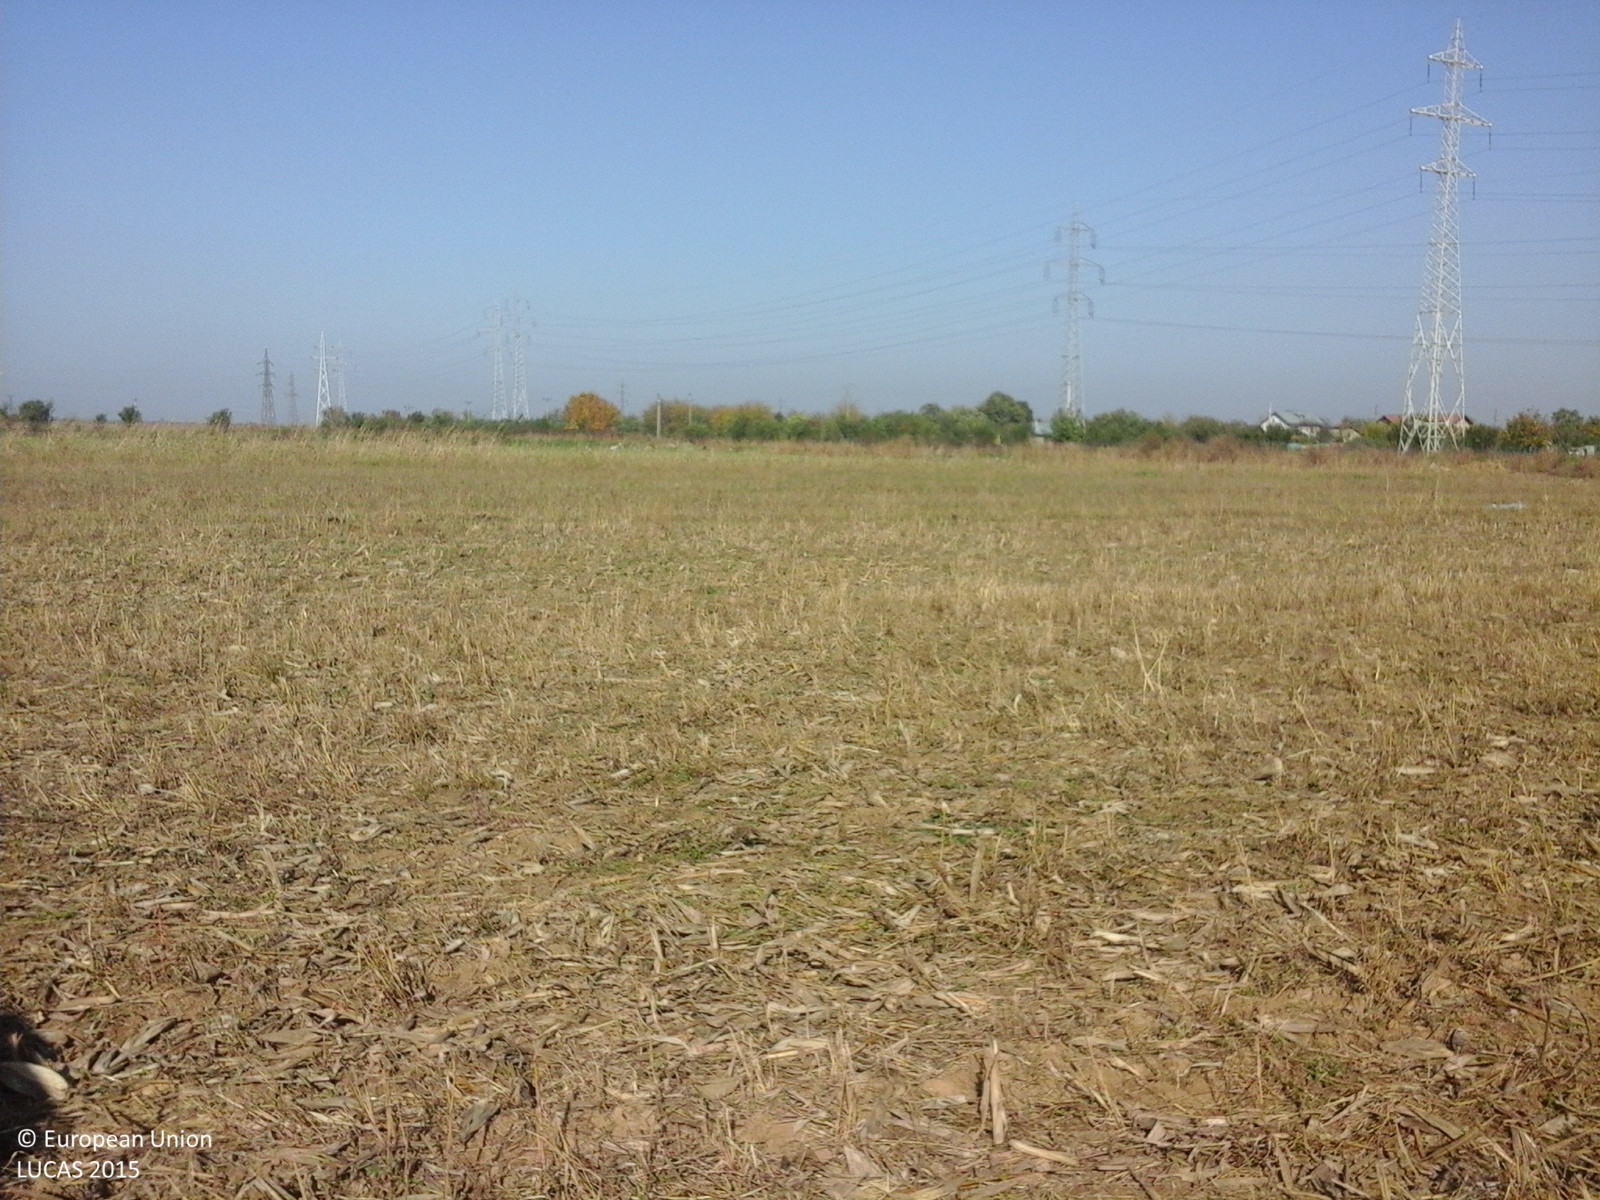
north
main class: Cropland
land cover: Maize
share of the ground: < 10 %
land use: Agriculture (excluding fallow land and kitchen gardens)
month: October
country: RO
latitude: 45.1332
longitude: 26.7214
